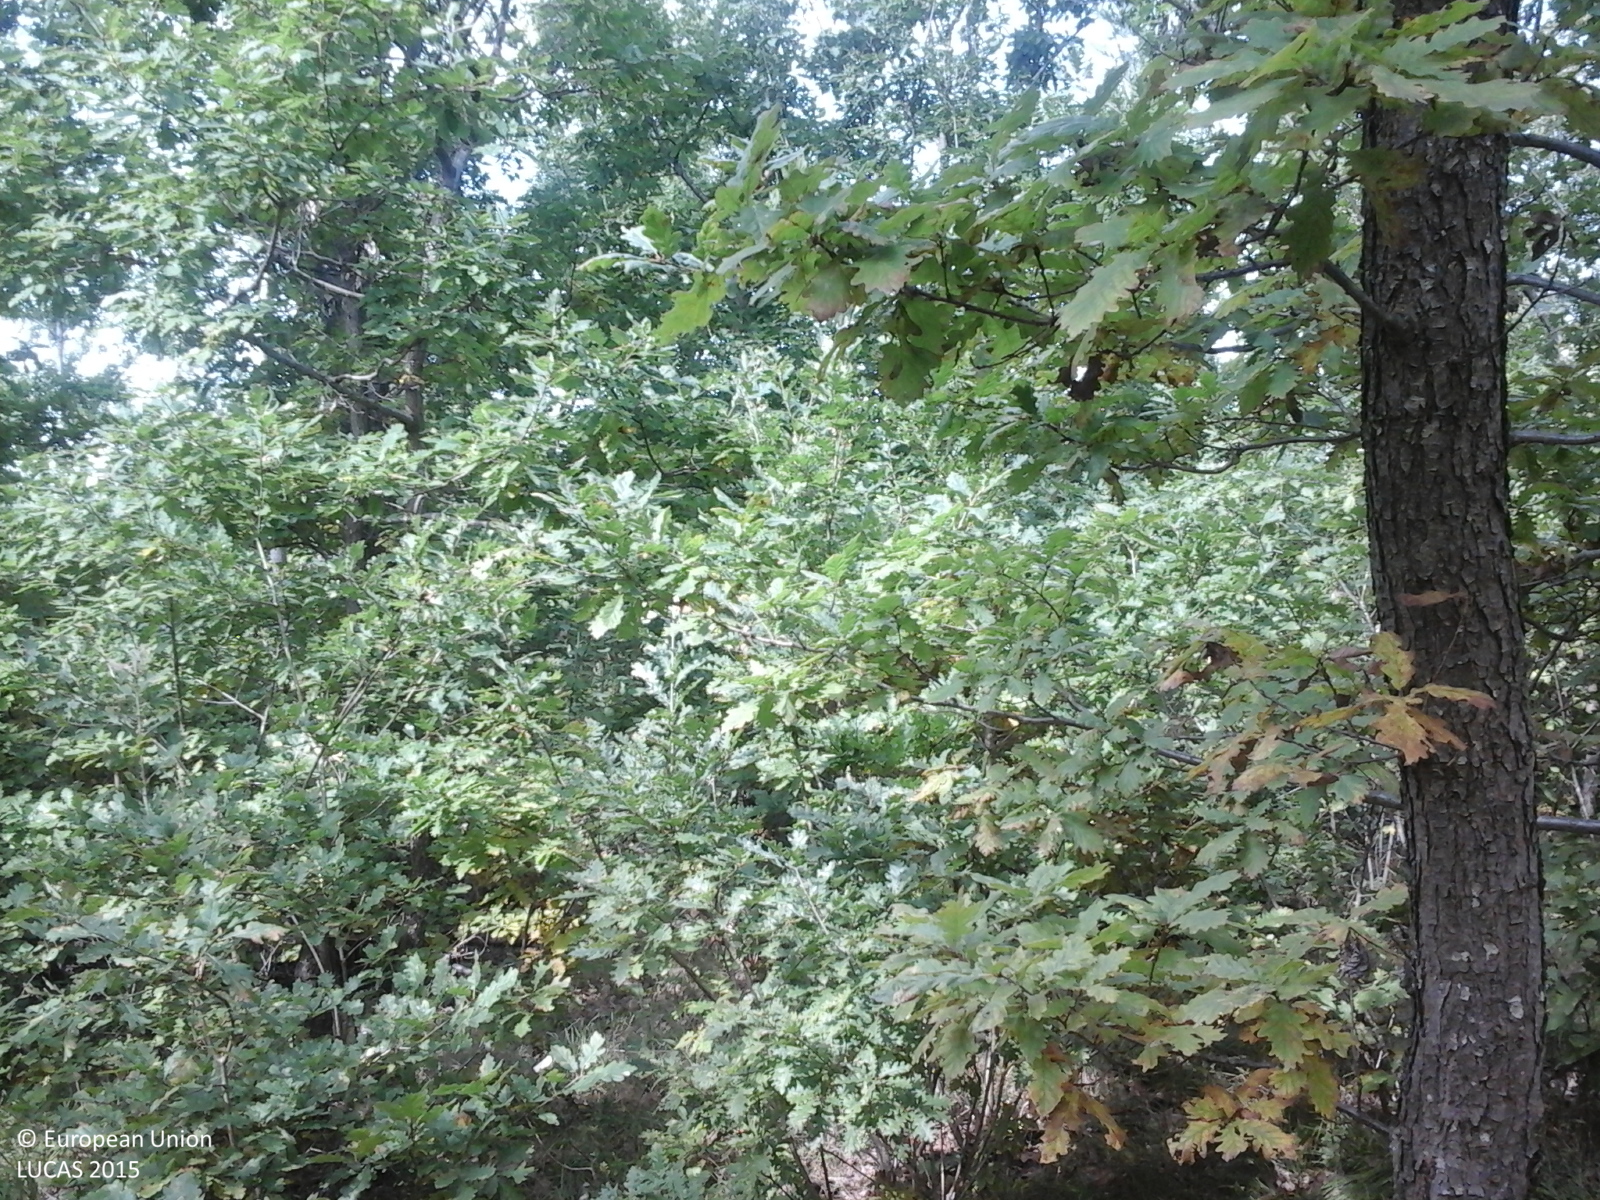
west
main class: Woodland
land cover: Broadleaved woodland
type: acidophilous oak and oak-birch forest
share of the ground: > 75 %
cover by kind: broadleaved forest trees 100 %
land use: Forestry
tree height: > 5 m
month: September
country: RO
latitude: 46.6566
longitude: 23.5157
